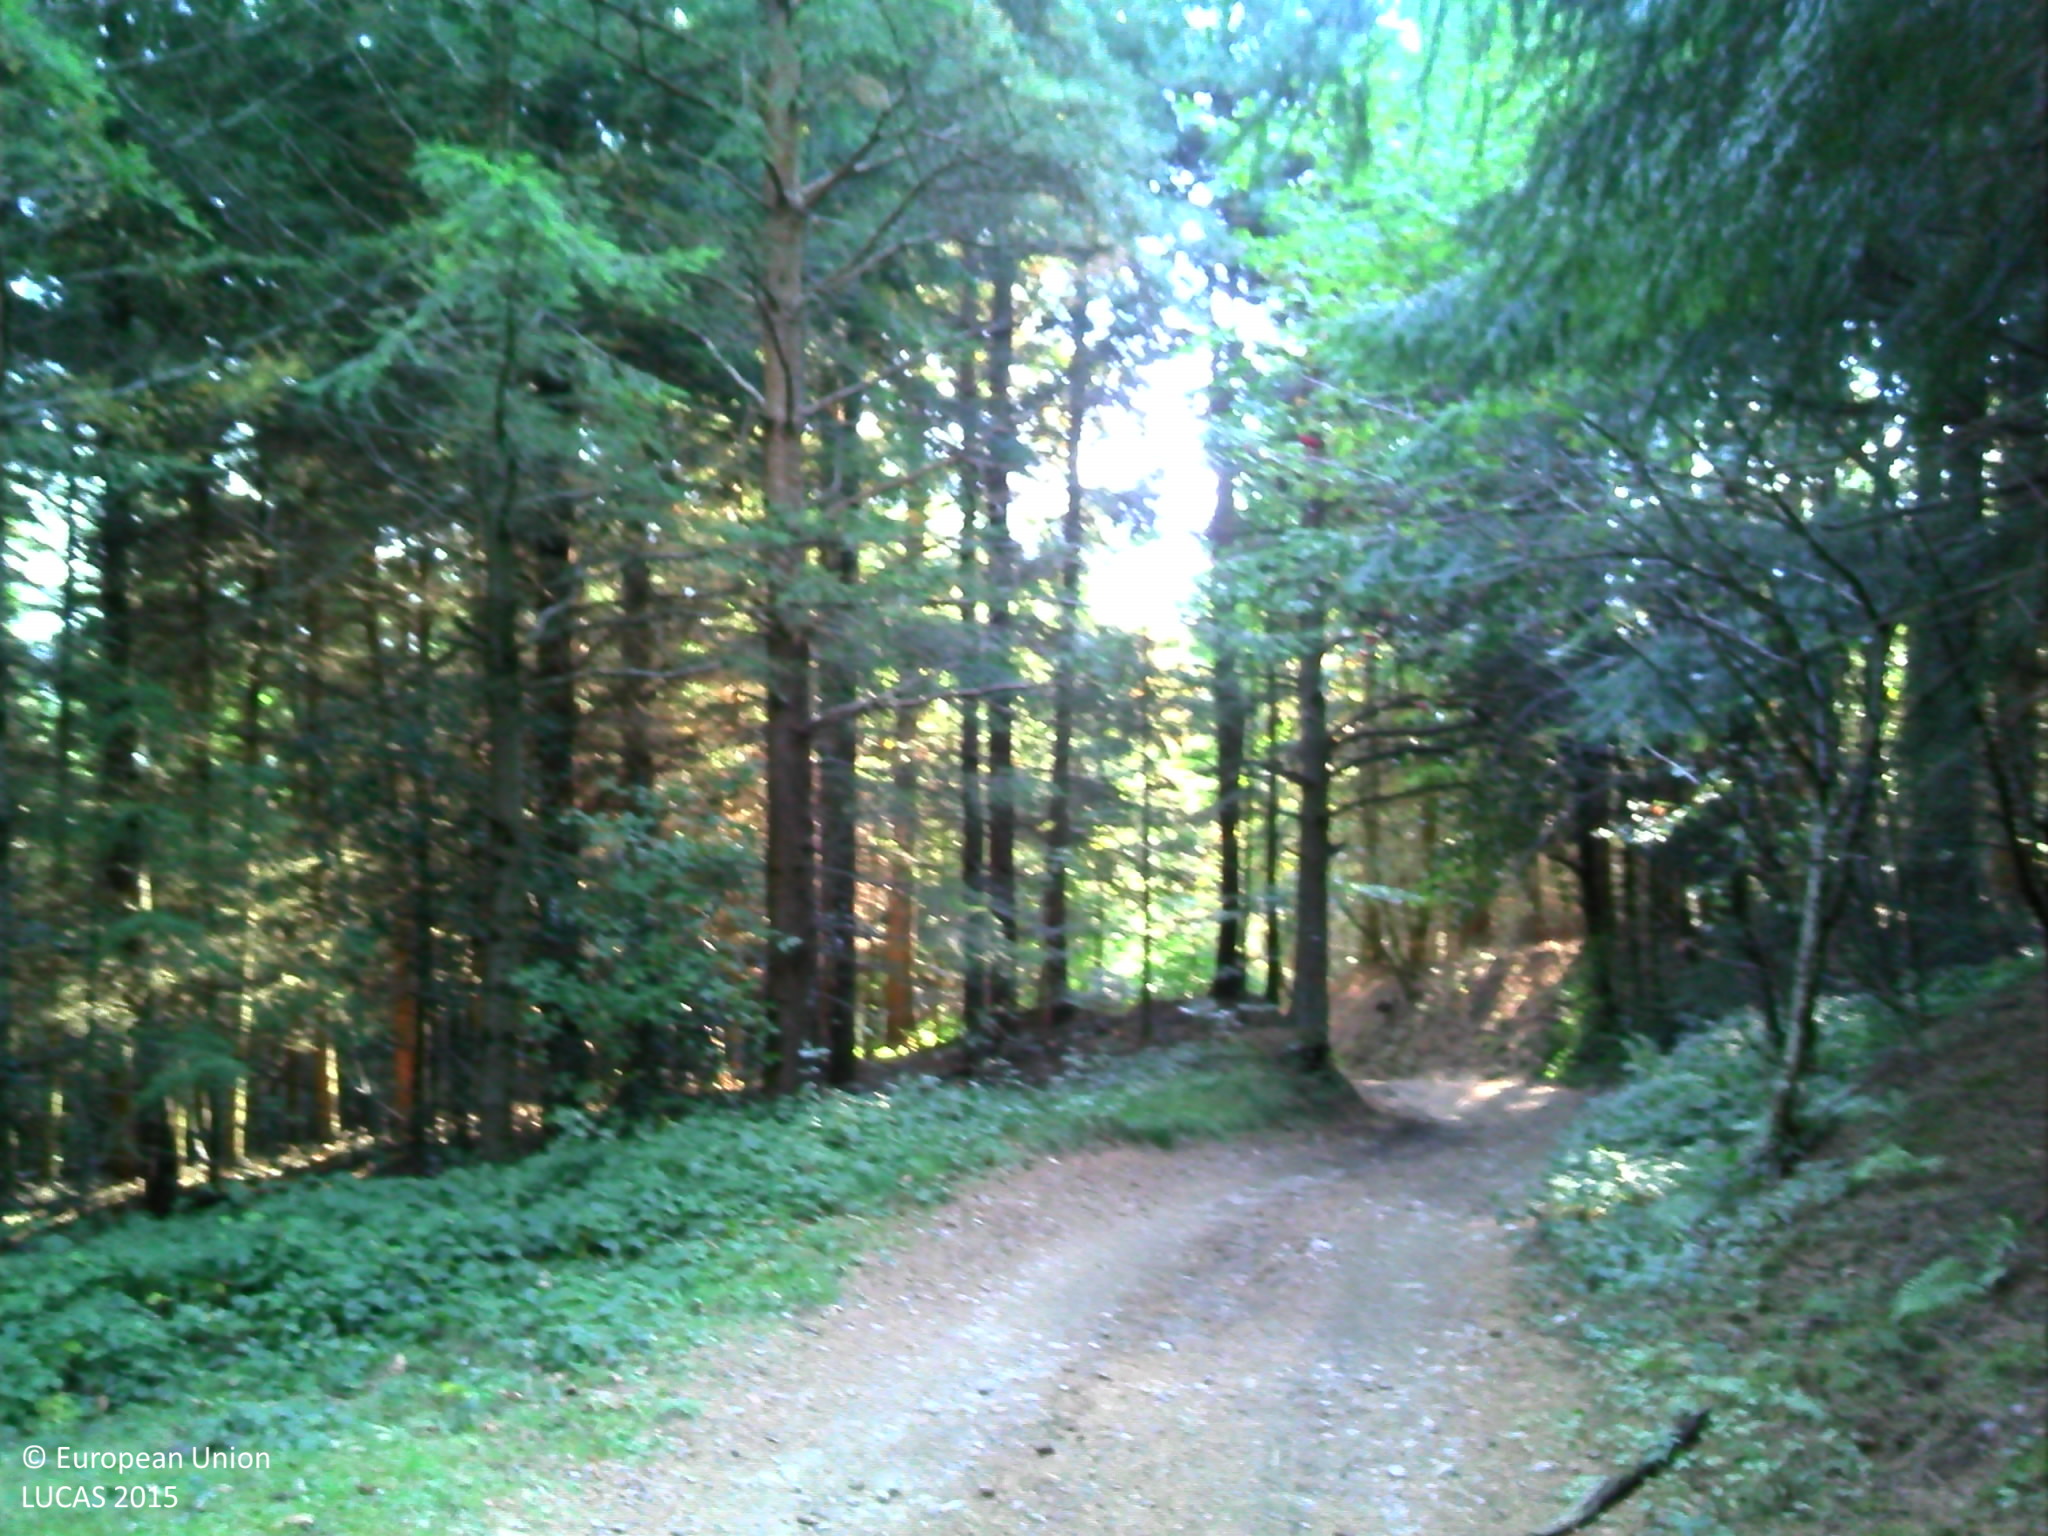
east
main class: Woodland
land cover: Spruce dominated coniferous woodland
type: alpine coniferous forest
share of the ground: > 75 %
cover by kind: coniferous forest trees 95 %, herbaceous plants 5 %
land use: Forestry
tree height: > 5 m
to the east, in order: Other coniferous woodland; Tracks; Other coniferous woodland; Tracks; Other coniferous woodland; Ditches and canals; Other coniferous woodland; Ditches and canals; Other coniferous woodland; Tracks; Grass margins; Fences; Other coniferous woodland; Fences; Tracks; Fences; Grassland without tree/shrub cover; Ditches and canals; Single bushes/trees; Grassland without tree/shrub cover
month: September
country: FR
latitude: 45.4190
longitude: 4.5729
